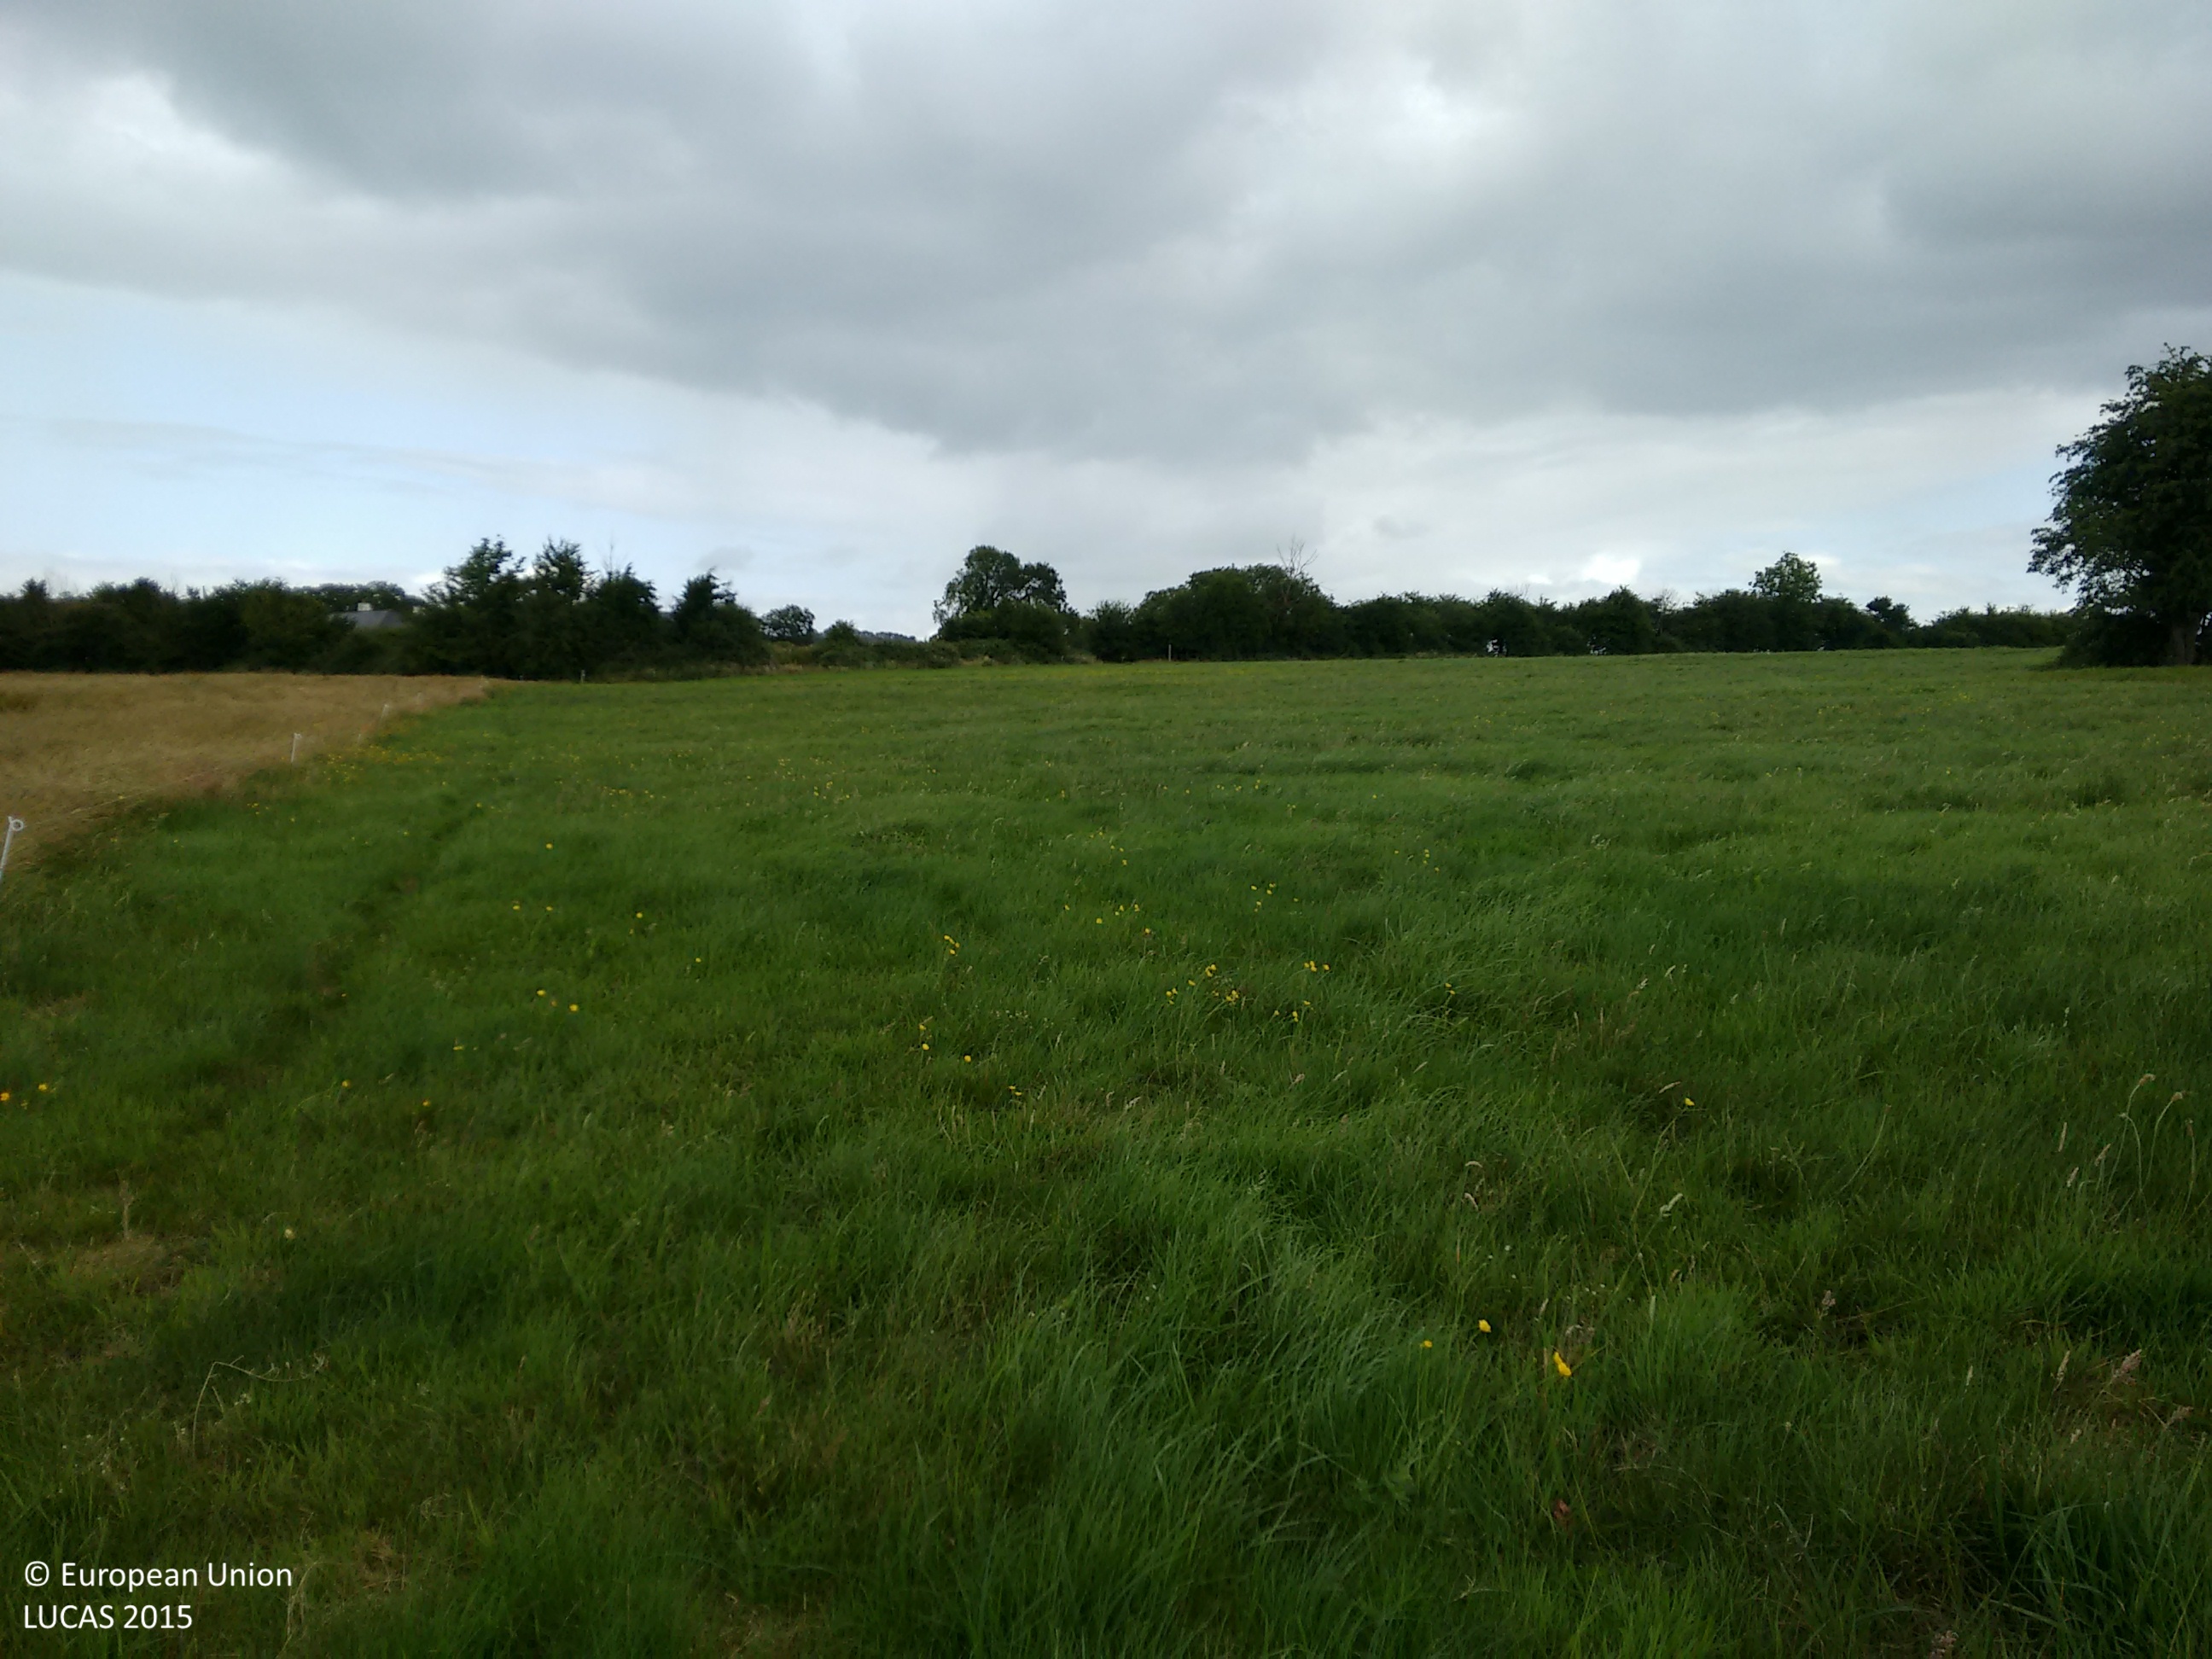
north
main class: Grassland
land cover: Grassland without tree/shrub cover
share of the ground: > 75 %
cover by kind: herbaceous plants 100 %
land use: Agriculture (excluding fallow land and kitchen gardens)
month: July
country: IE
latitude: 52.7948
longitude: -7.3726
